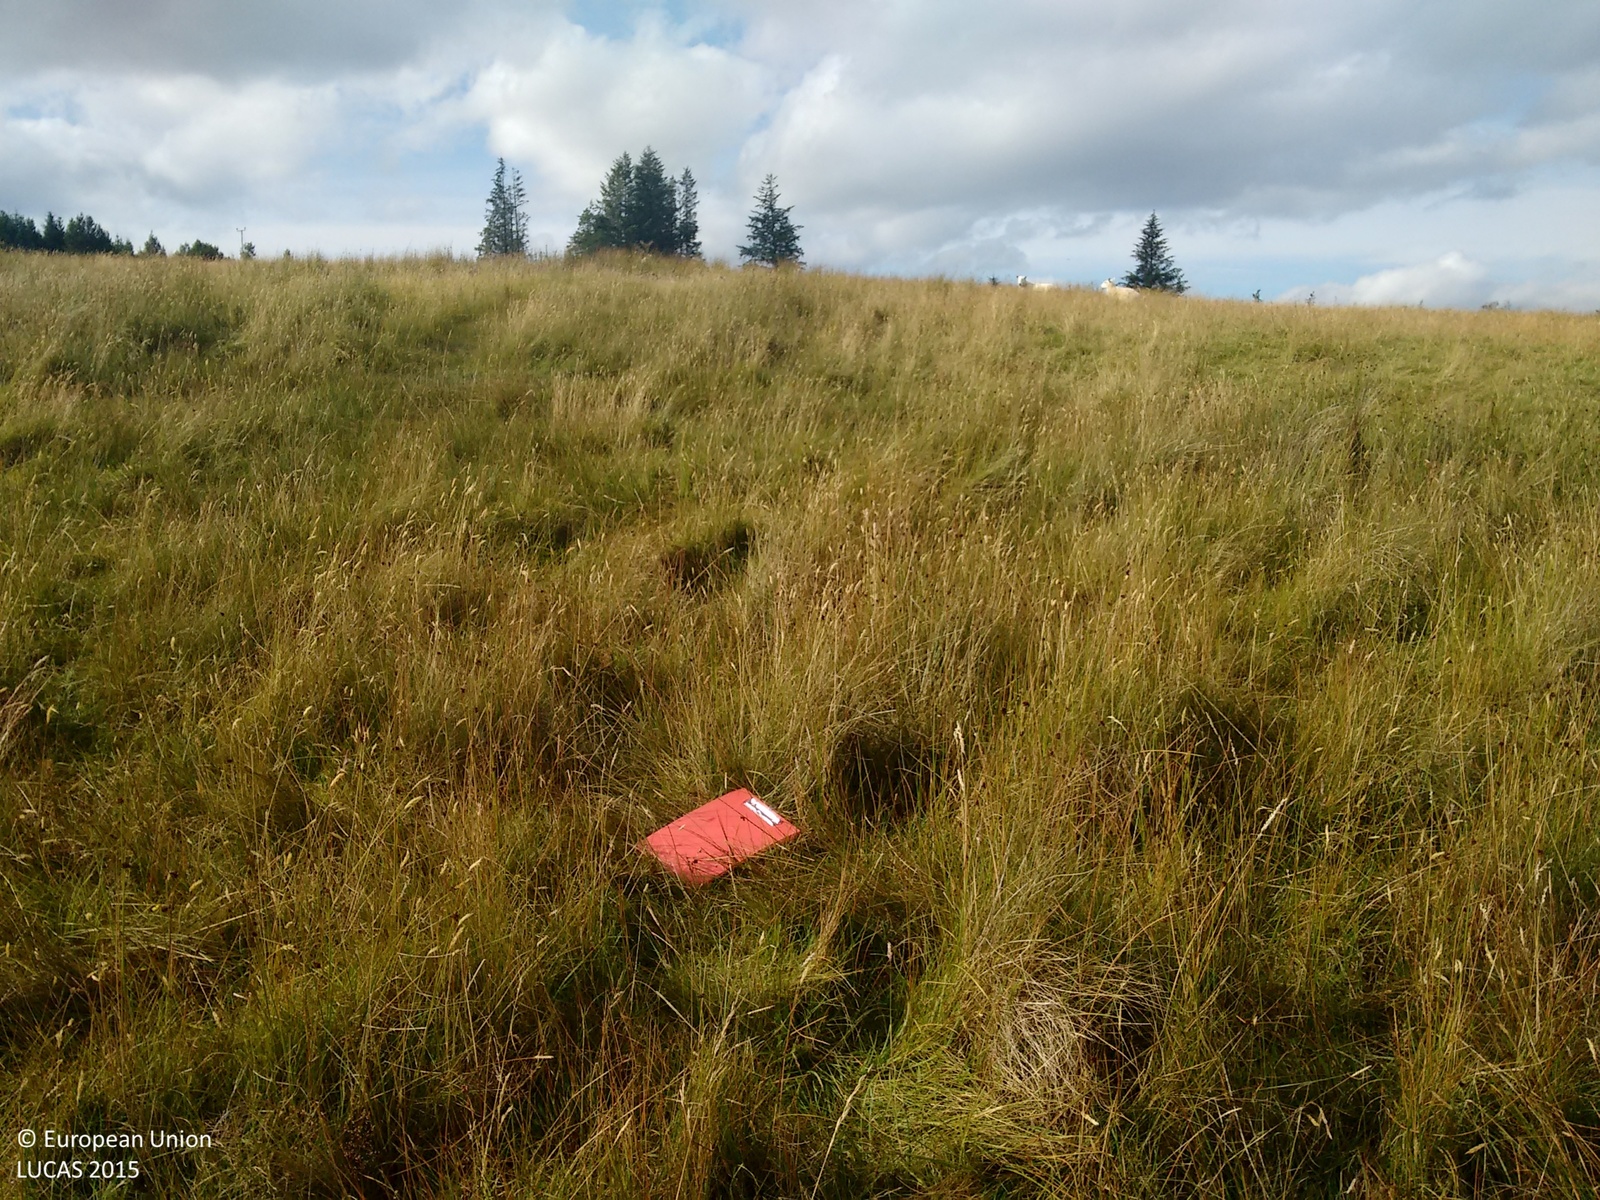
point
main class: Grassland
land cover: Grassland without tree/shrub cover
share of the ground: > 75 %
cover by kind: herbaceous plants 100 %
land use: Agriculture (excluding fallow land and kitchen gardens)
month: September
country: GB
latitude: 57.9127
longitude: -4.4164
